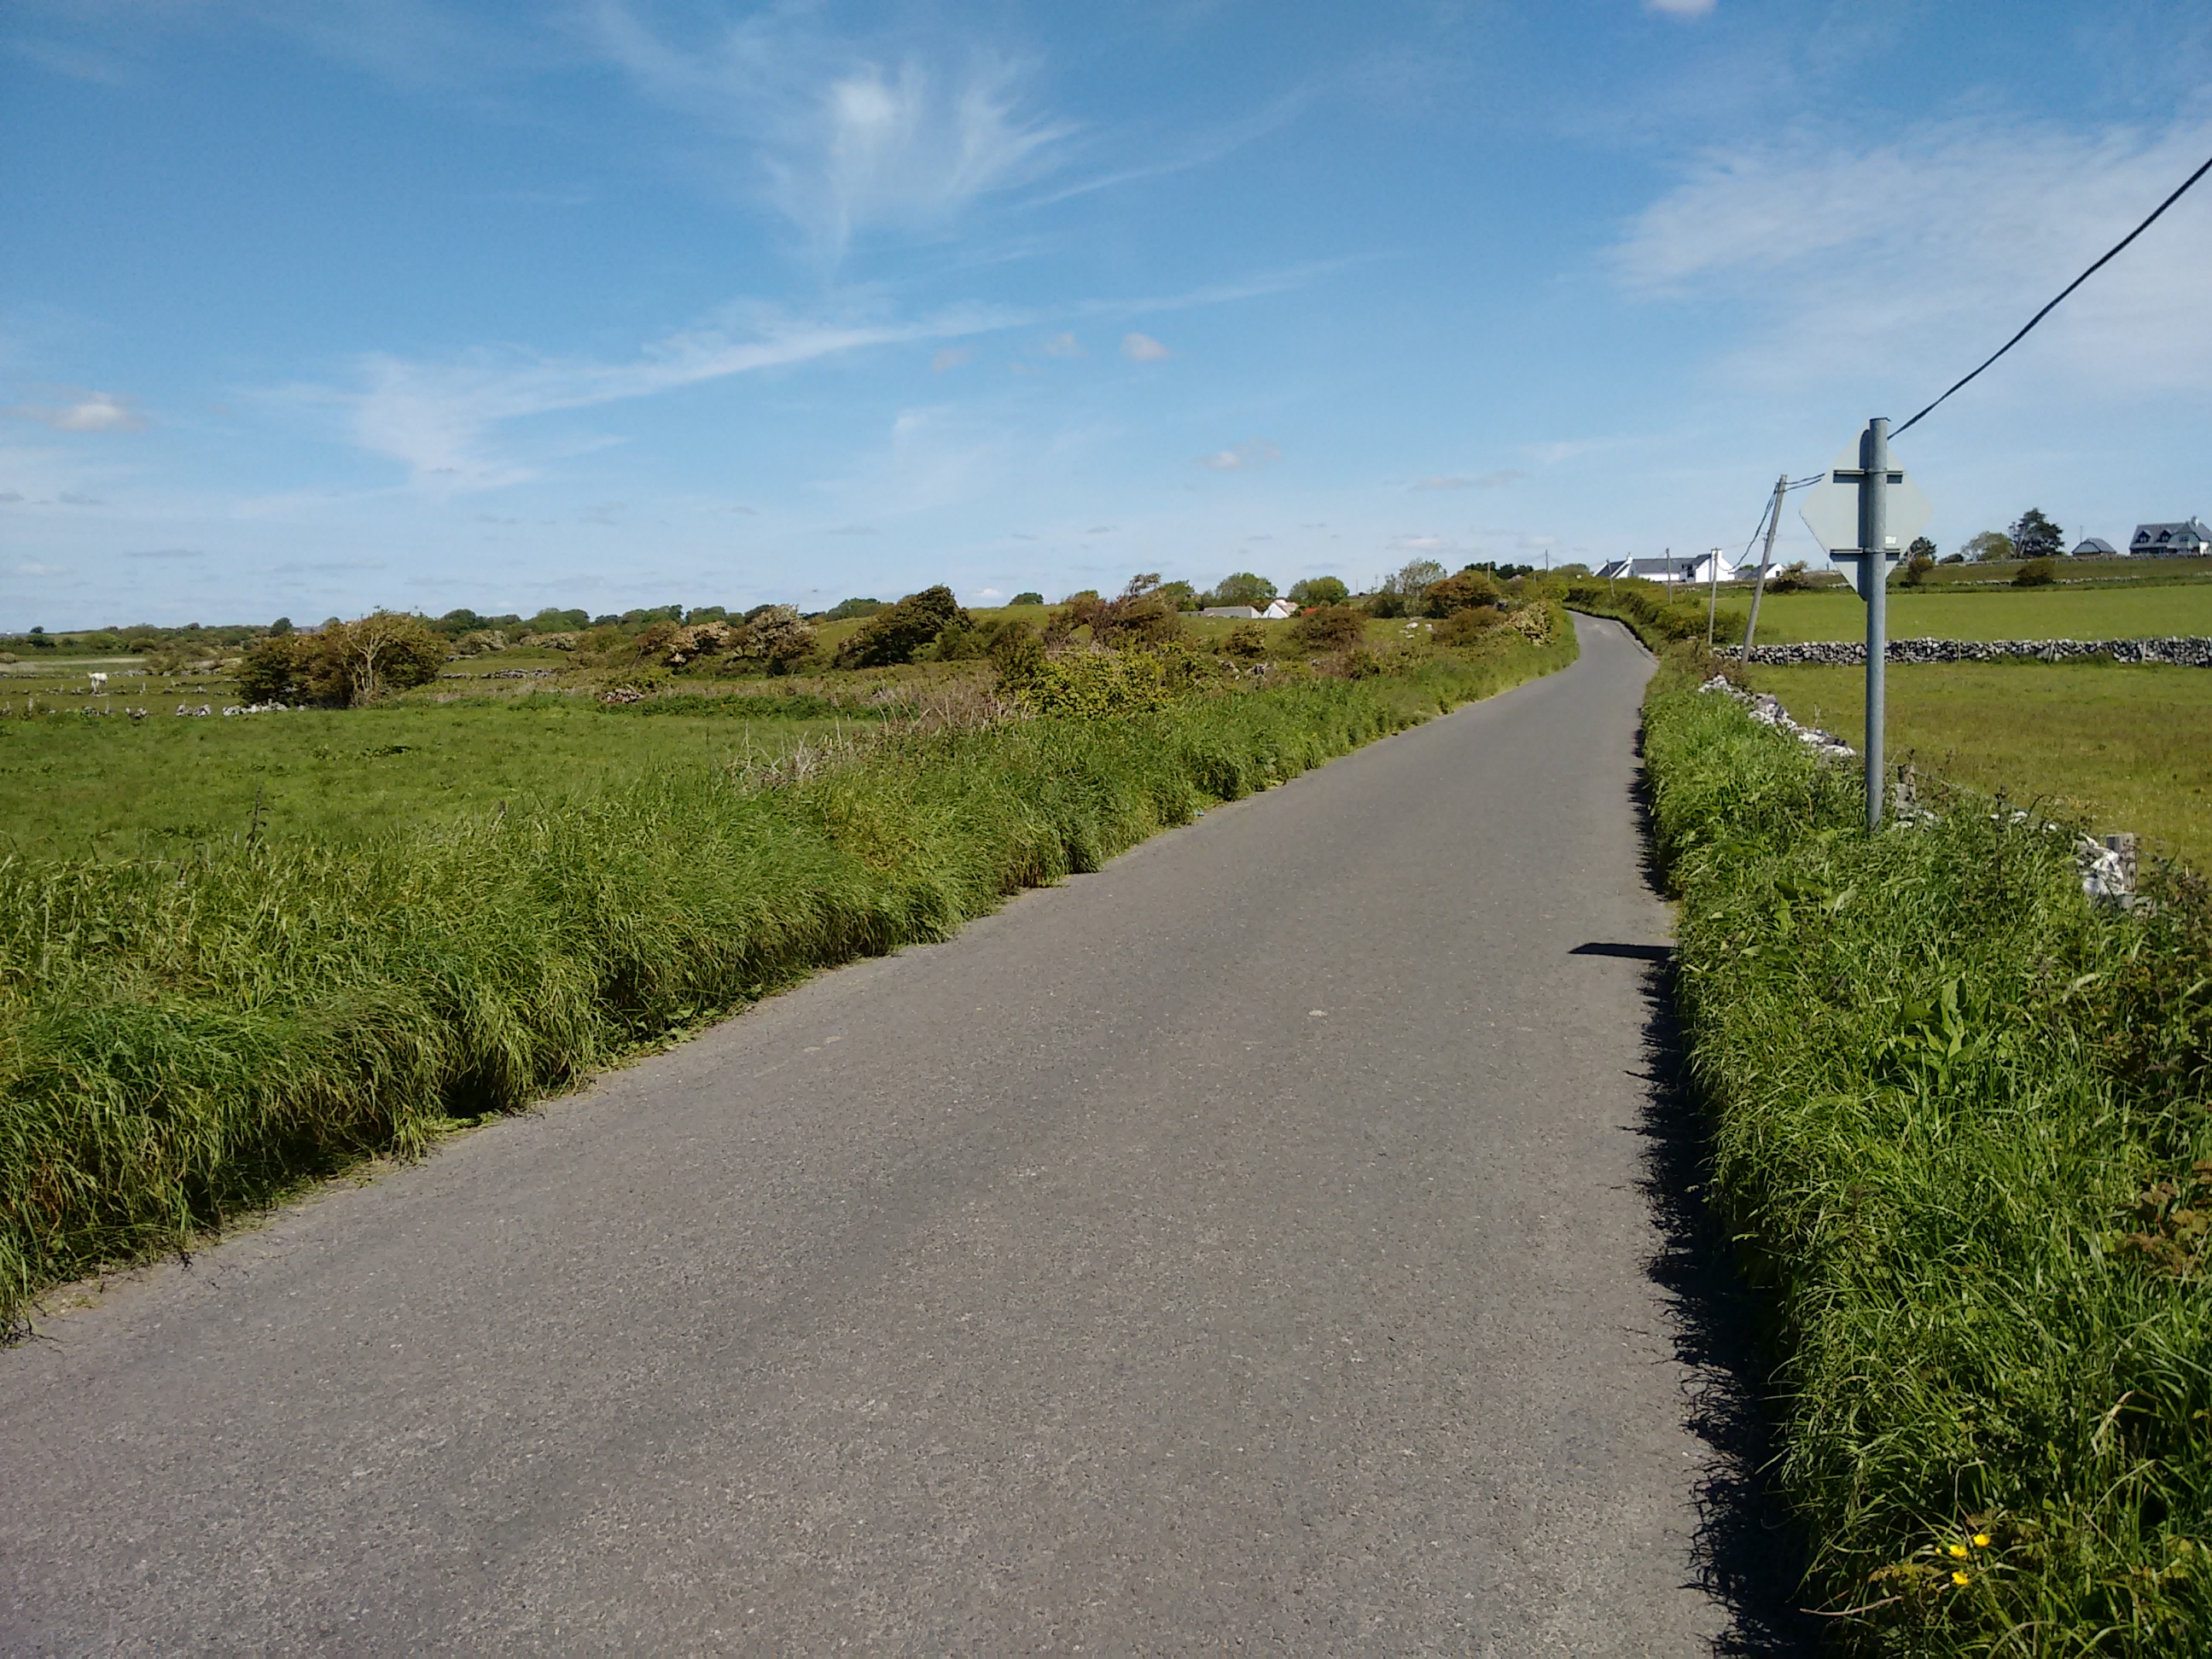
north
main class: Grassland
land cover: Grassland without tree/shrub cover
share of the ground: > 75 %
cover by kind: herbaceous plants 100 %
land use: Agriculture (excluding fallow land and kitchen gardens)
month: June
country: IE
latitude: 53.2178
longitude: -8.9457
